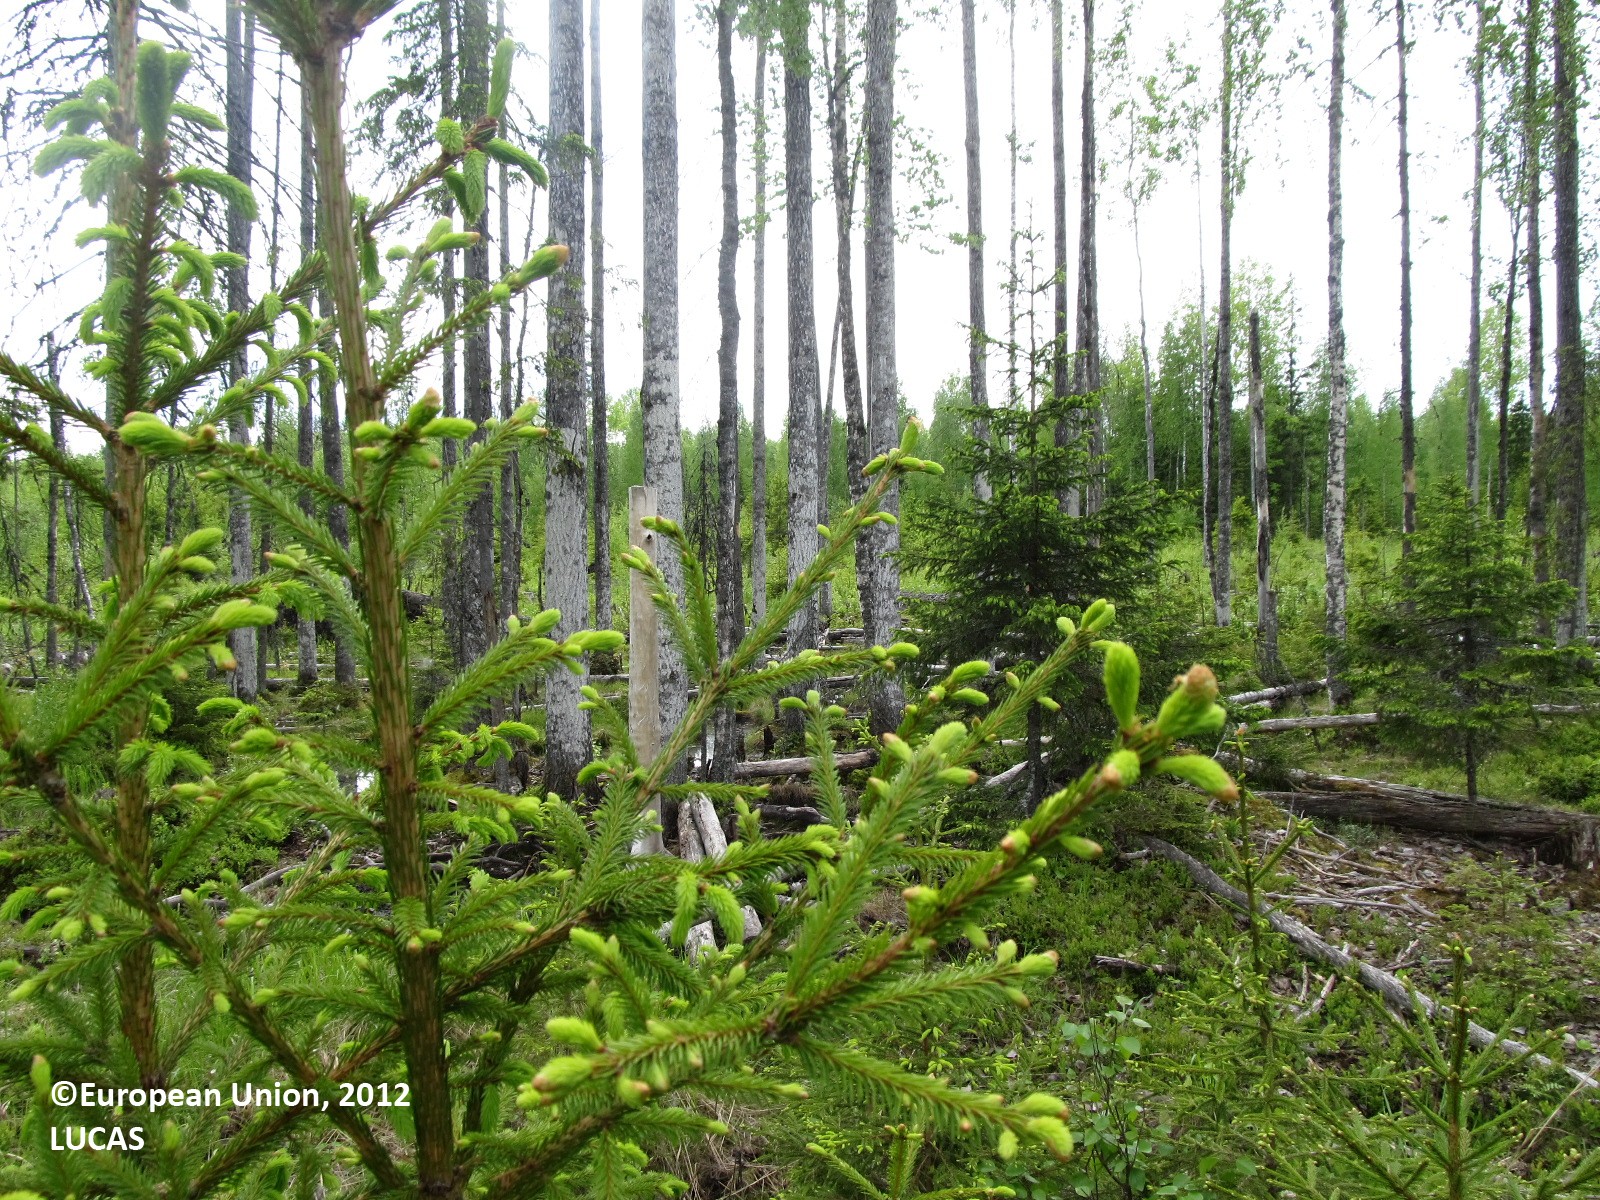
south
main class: Woodland
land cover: Spruce dominated coniferous woodland
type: boreal forest
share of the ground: 25 - 50 %
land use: Forestry
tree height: < 5 m
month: June
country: FI
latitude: 62.5795
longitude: 28.8402
